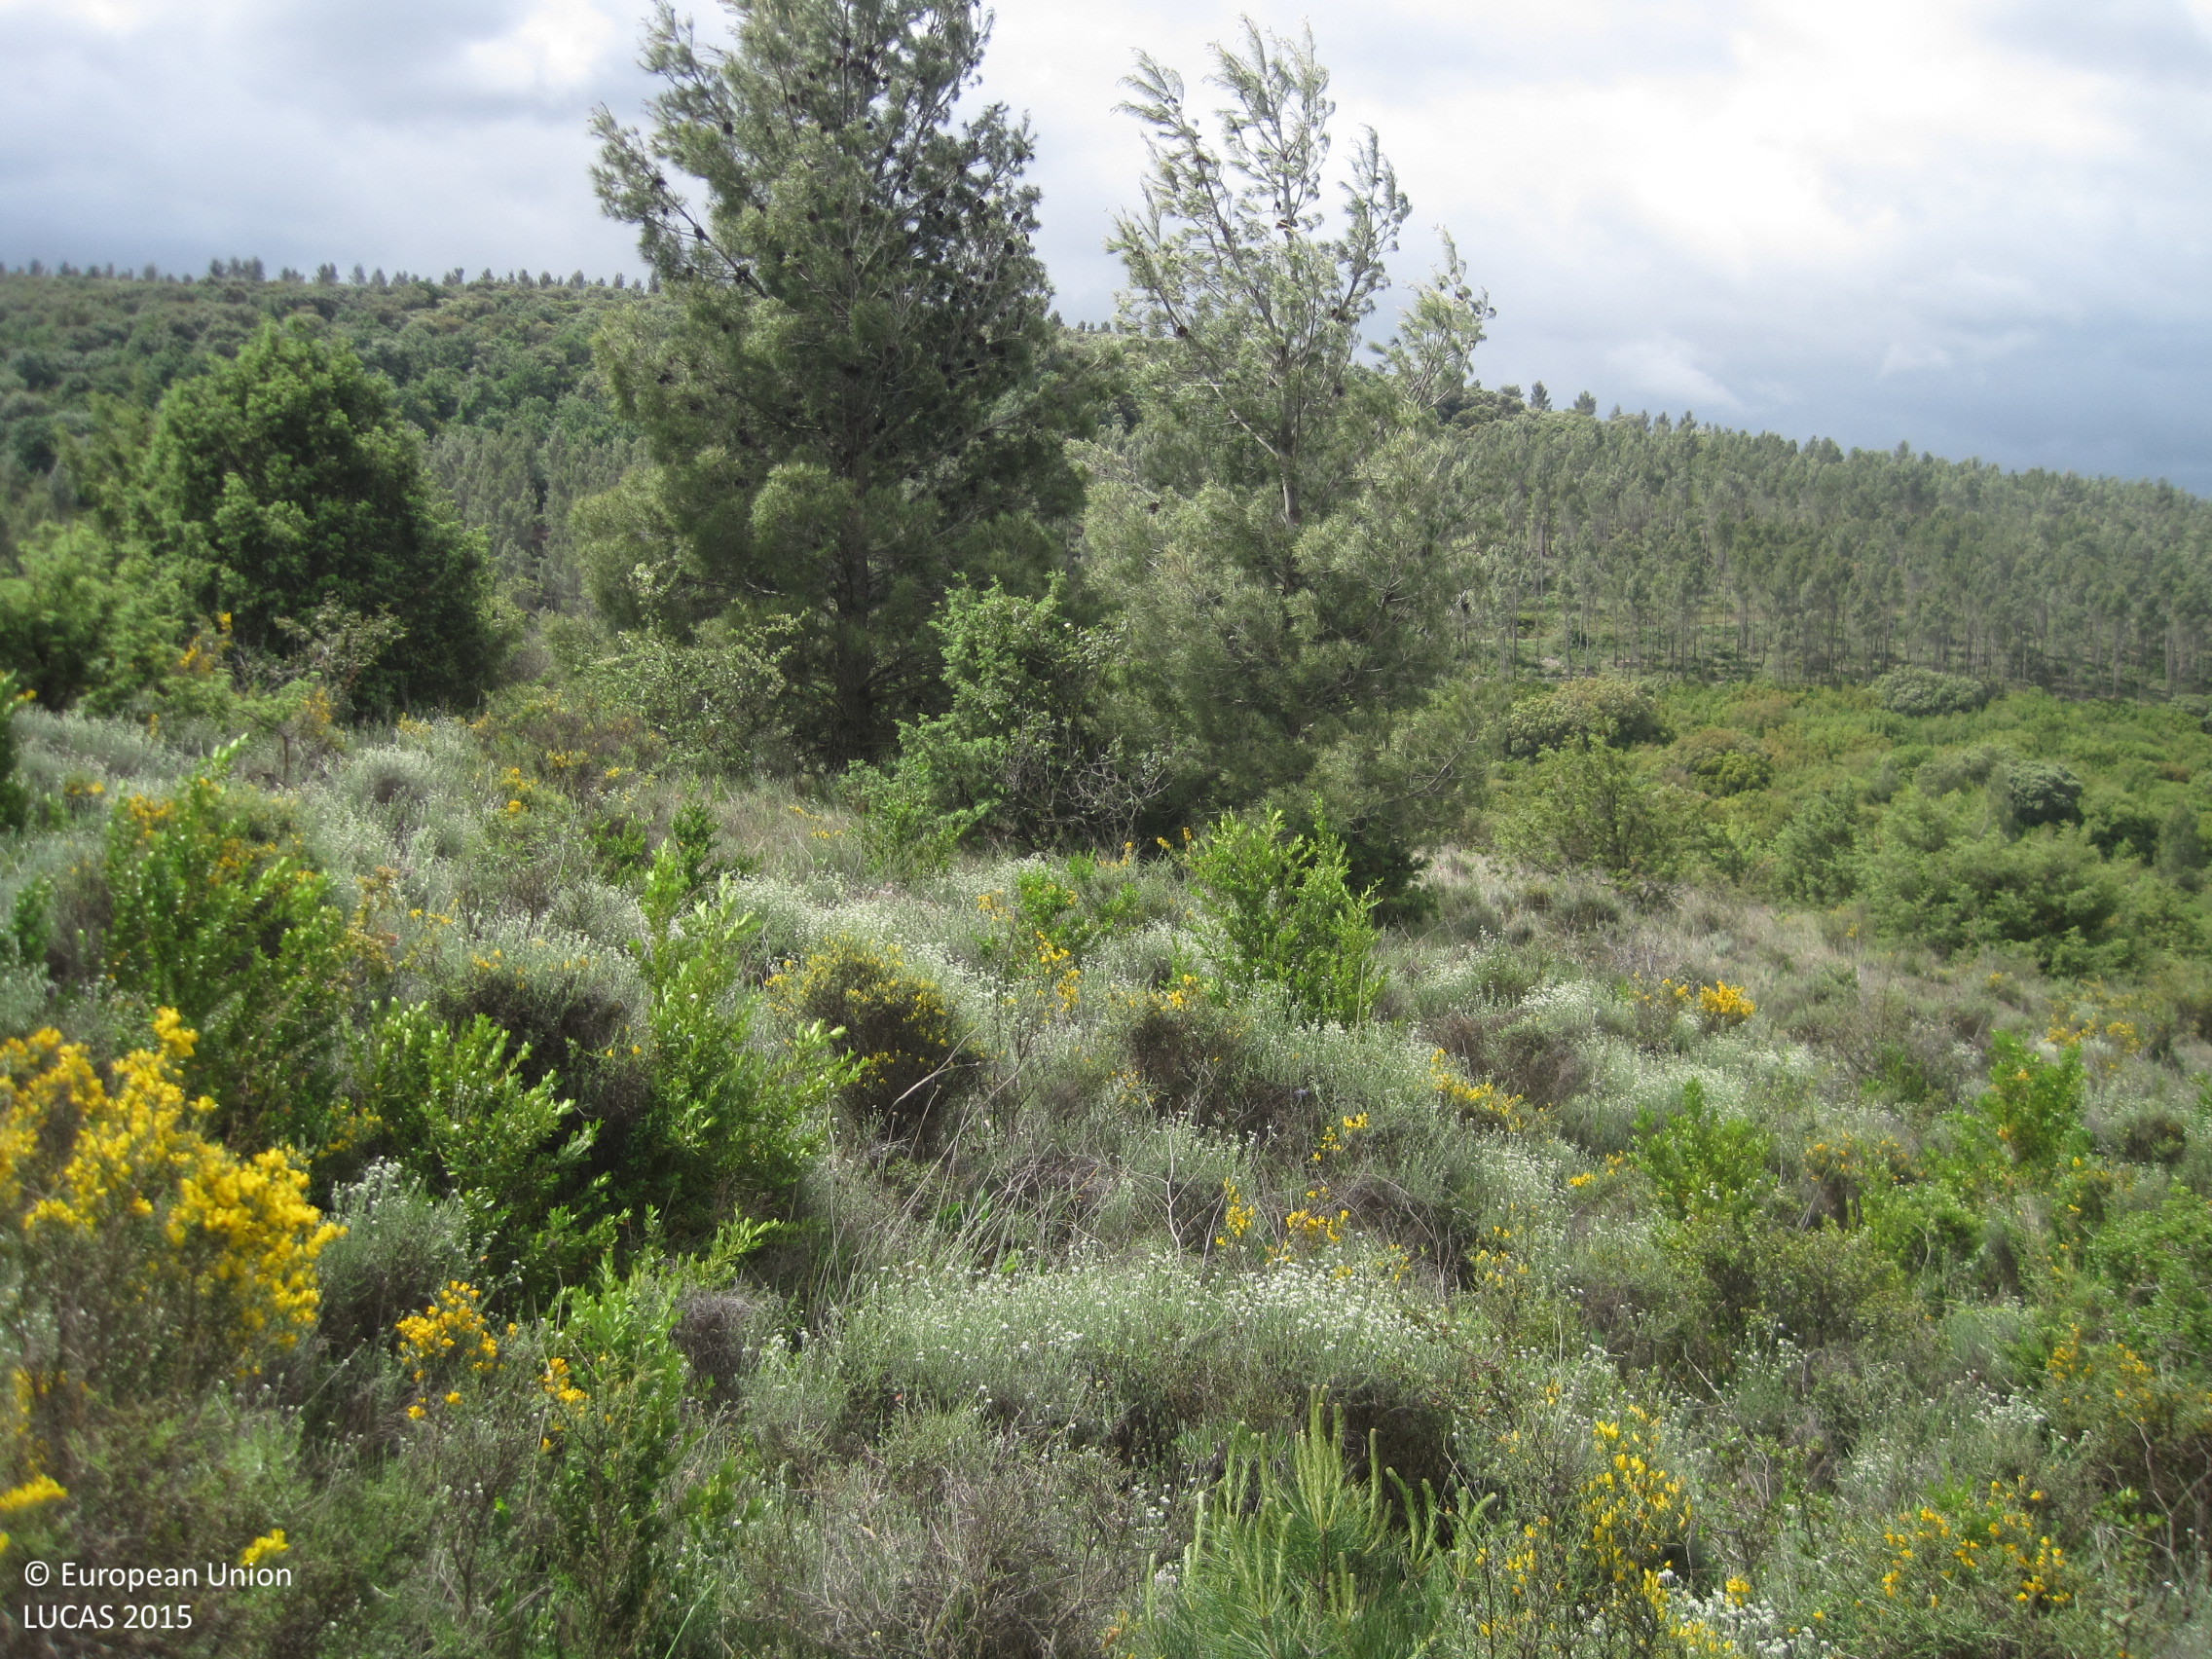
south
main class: Shrubland
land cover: Shrubland with sparse tree cover
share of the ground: > 75 %
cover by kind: shrubs 90 %, broadleaved forest trees 5 %, herbaceous plants 5 %
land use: Semi-natural and natural areas not in use
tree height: > 5 m
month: May
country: ES
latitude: 42.6124
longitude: -1.2117
